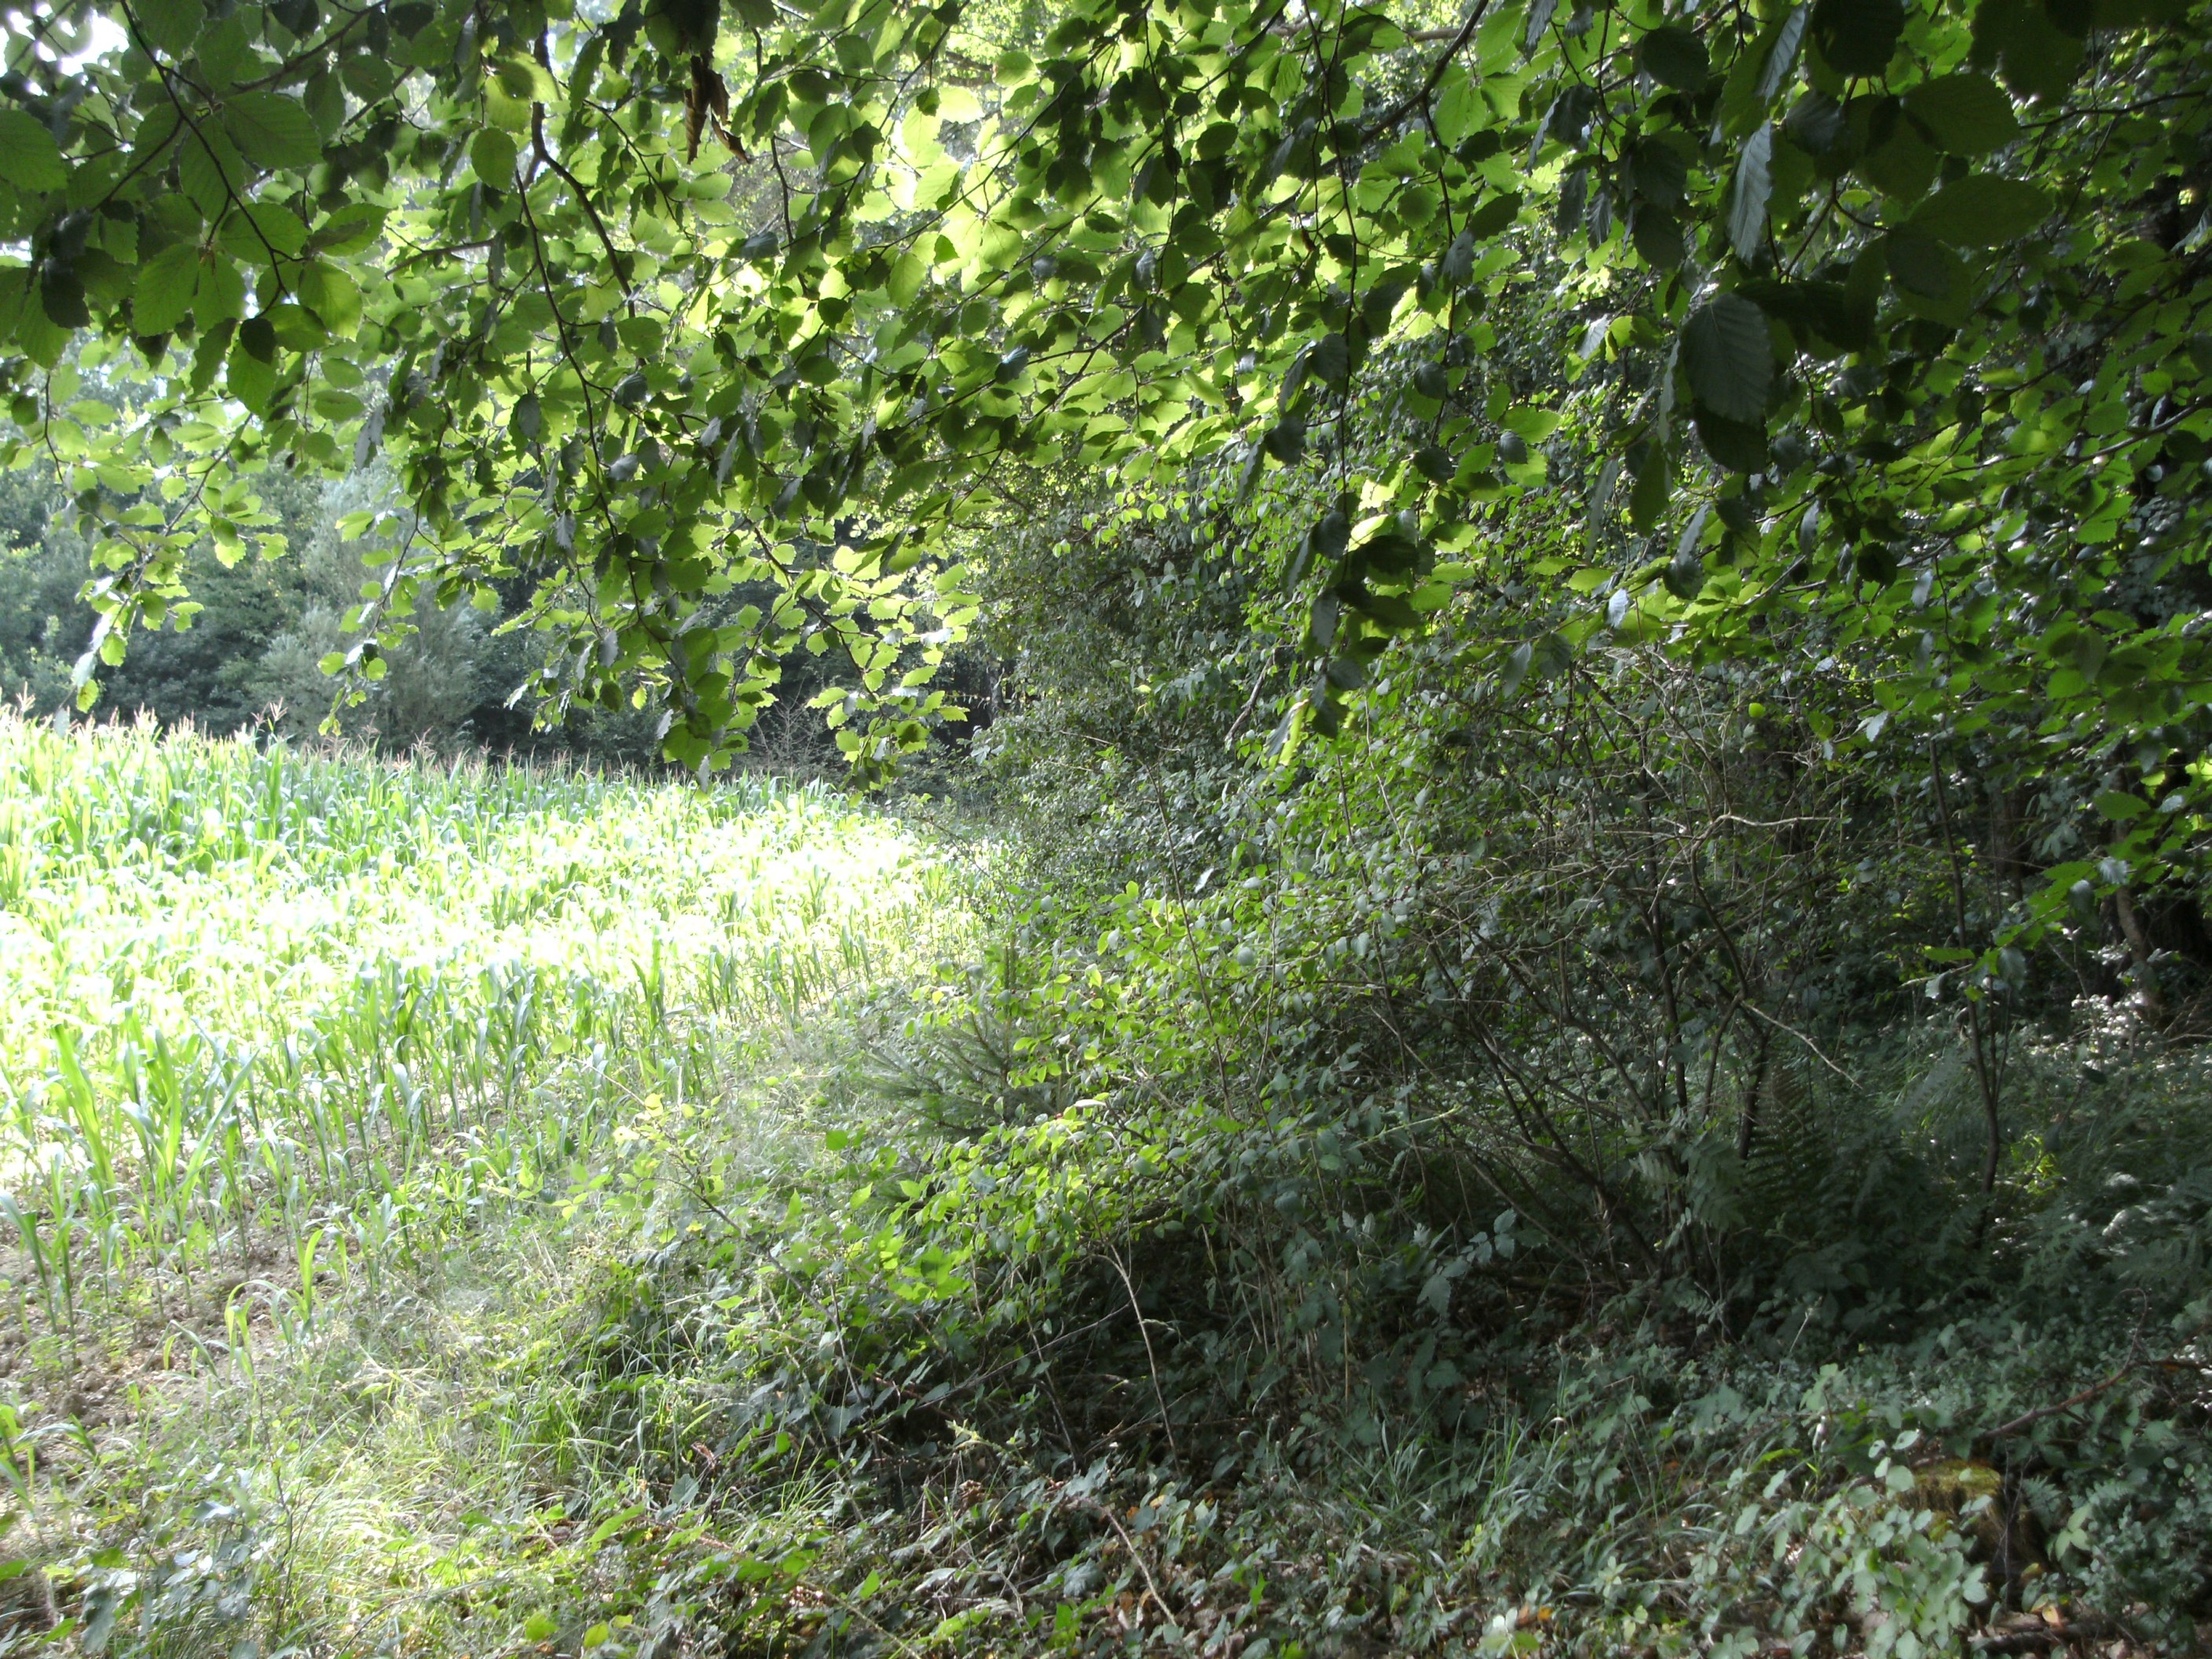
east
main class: Woodland
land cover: Spruce dominated mixed woodland
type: hemiboreal forest and nemoral coniferous forest and mixed broadleaved-coniferous forest
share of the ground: > 75 %
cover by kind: coniferous forest trees 45 %, broadleaved forest trees 45 %, shrubs 5 %, herbaceous plants 5 %
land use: Forestry
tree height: > 5 m
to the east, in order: Spruce dominated mixed woodland; Maize; Other mixed woodland; Other coniferous woodland; Tracks; Pine dominated mixed woodland; Grass margins; Maize; Electric lines; Maize; Electric lines; Maize
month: July
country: AT
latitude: 46.5600
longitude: 14.5762
